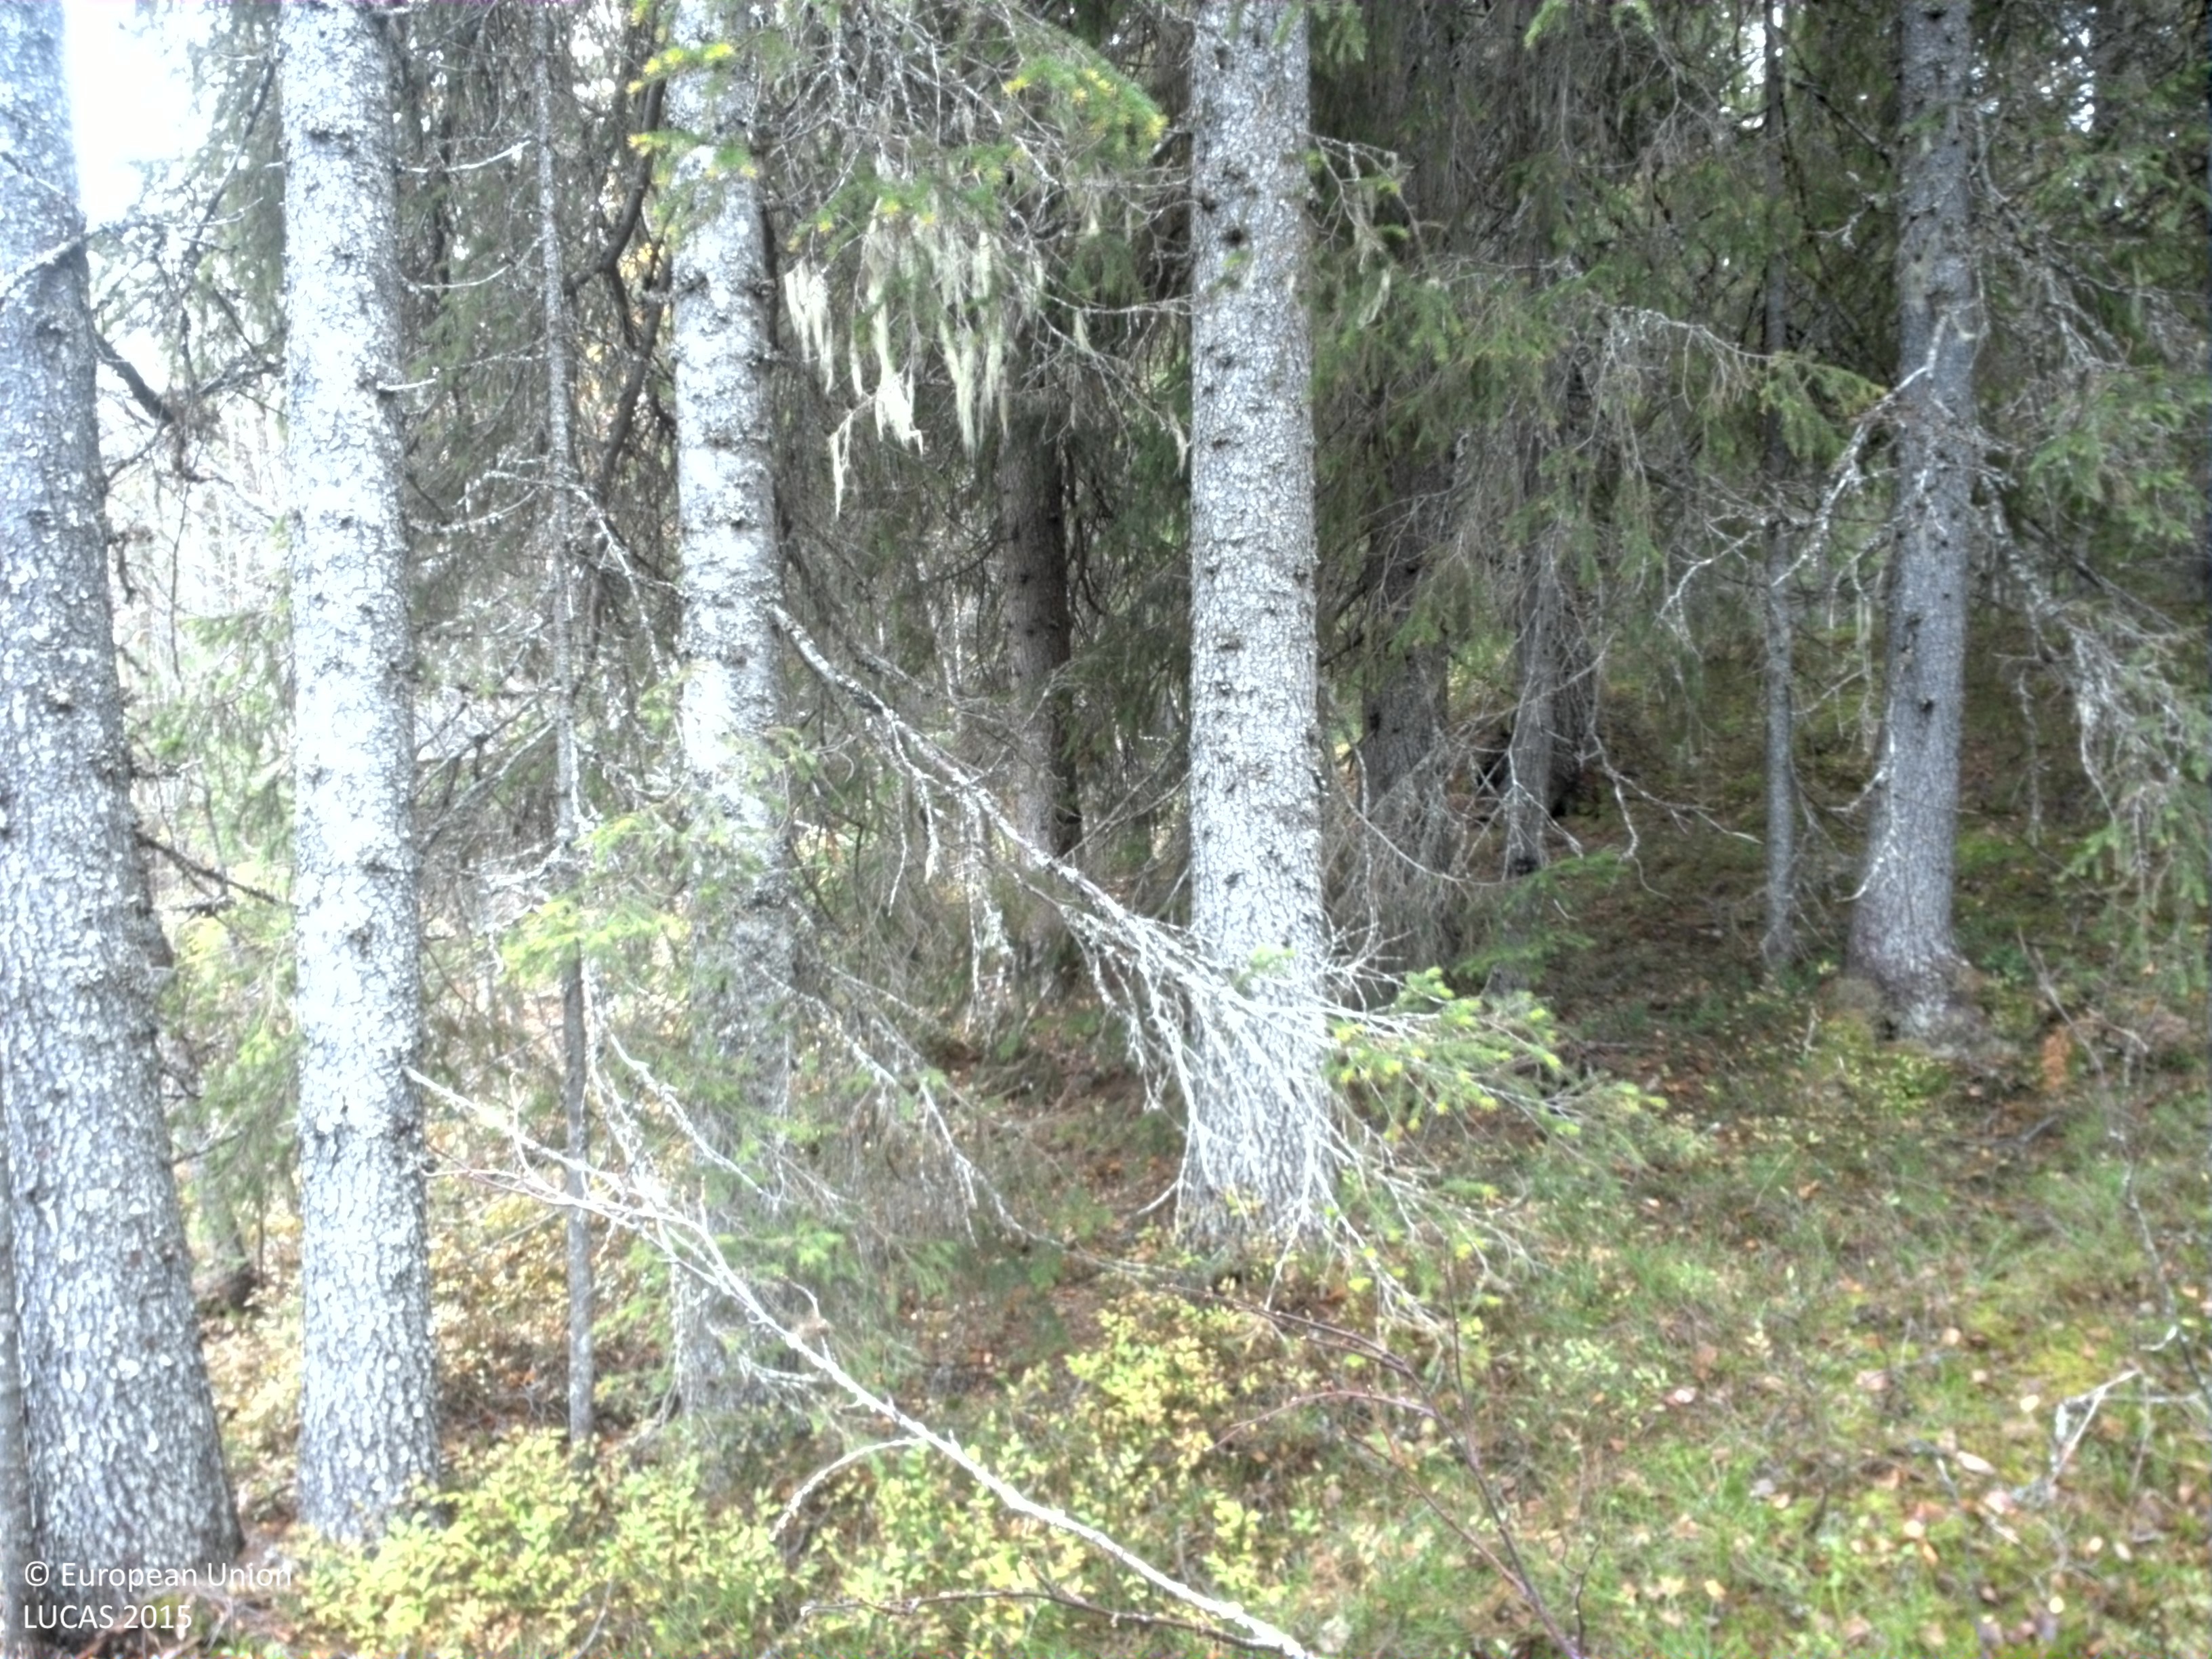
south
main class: Woodland
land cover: Spruce dominated mixed woodland
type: boreal forest
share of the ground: 25 - 50 %
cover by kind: shrubs 45 %, coniferous forest trees 25 %, broadleaved forest trees 10 %, herbaceous plants 10 %, lichens and mosses 10 %
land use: Forestry
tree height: > 5 m
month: October
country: SE
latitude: 64.4866
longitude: 16.3979
